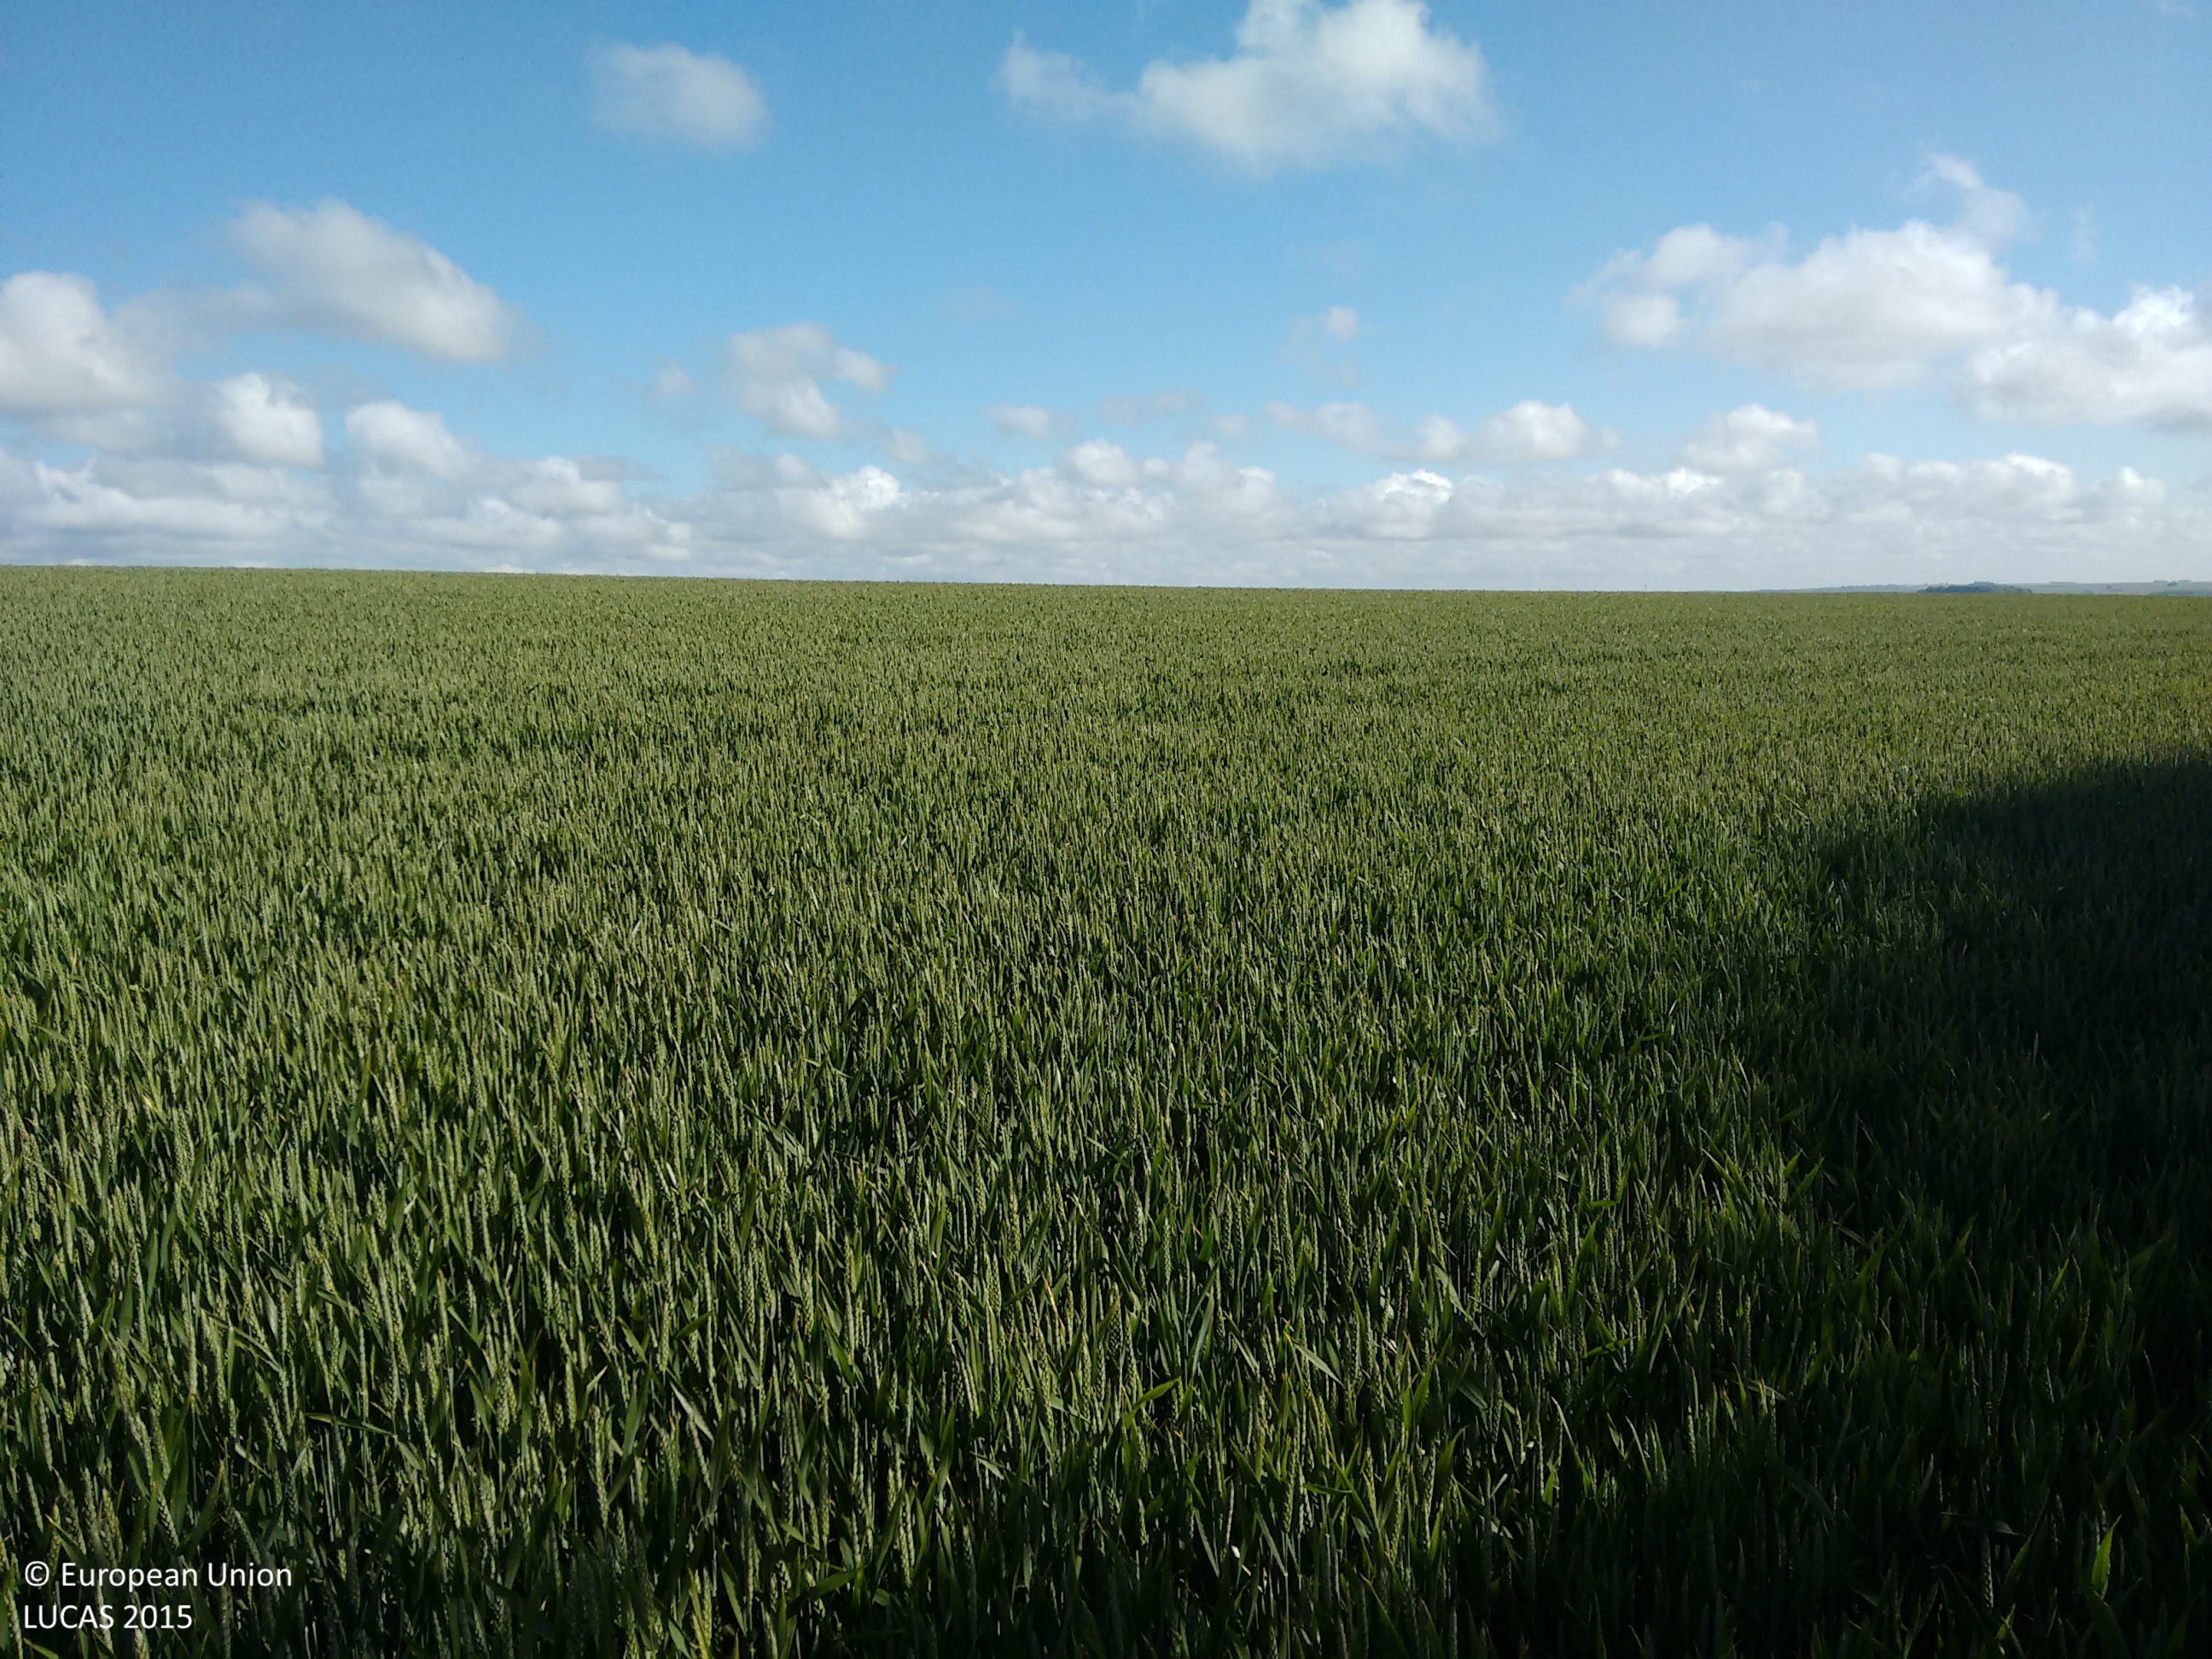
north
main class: Cropland
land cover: Common wheat
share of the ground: > 75 %
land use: Agriculture (excluding fallow land and kitchen gardens)
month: June
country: GB
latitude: 51.1513
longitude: -2.1410
